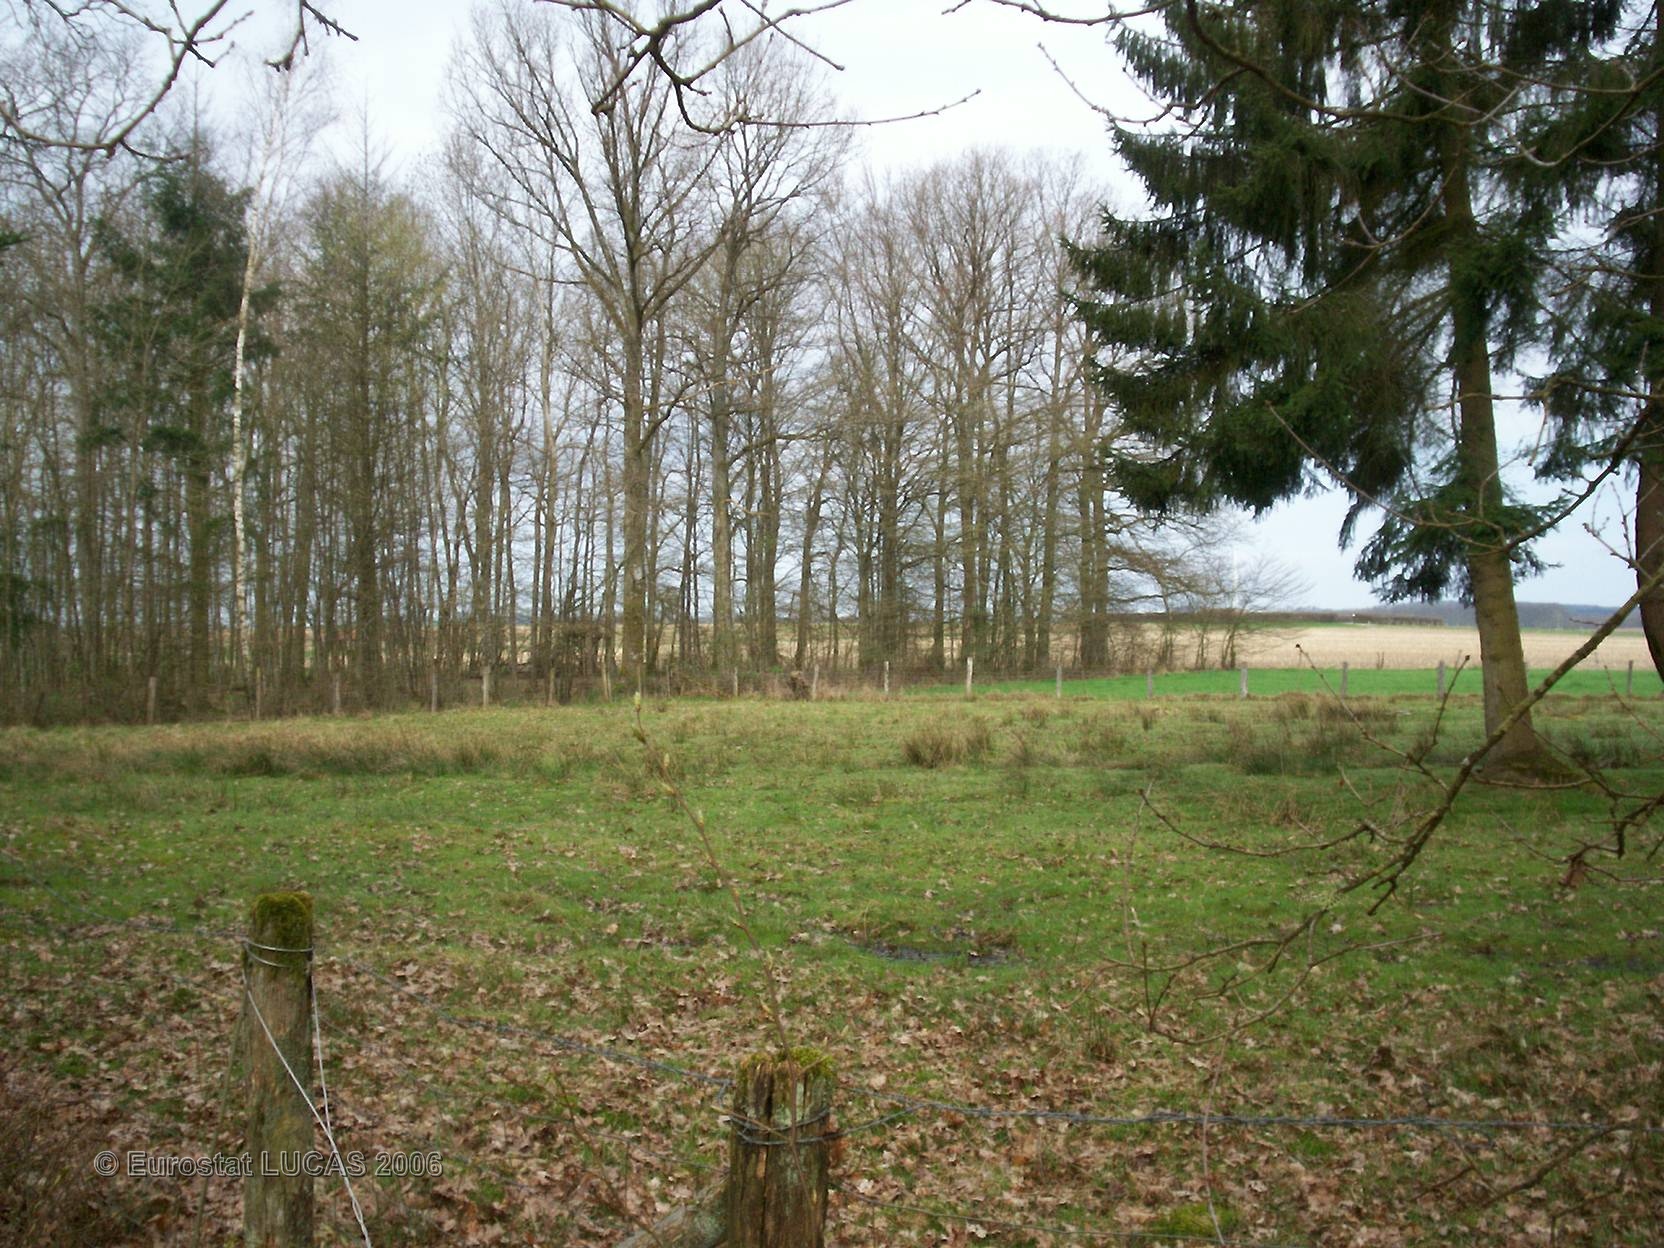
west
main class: Woodland
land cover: Broadleaved forest
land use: Forestry
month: April
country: FR
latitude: 48.0804
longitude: 6.0406
